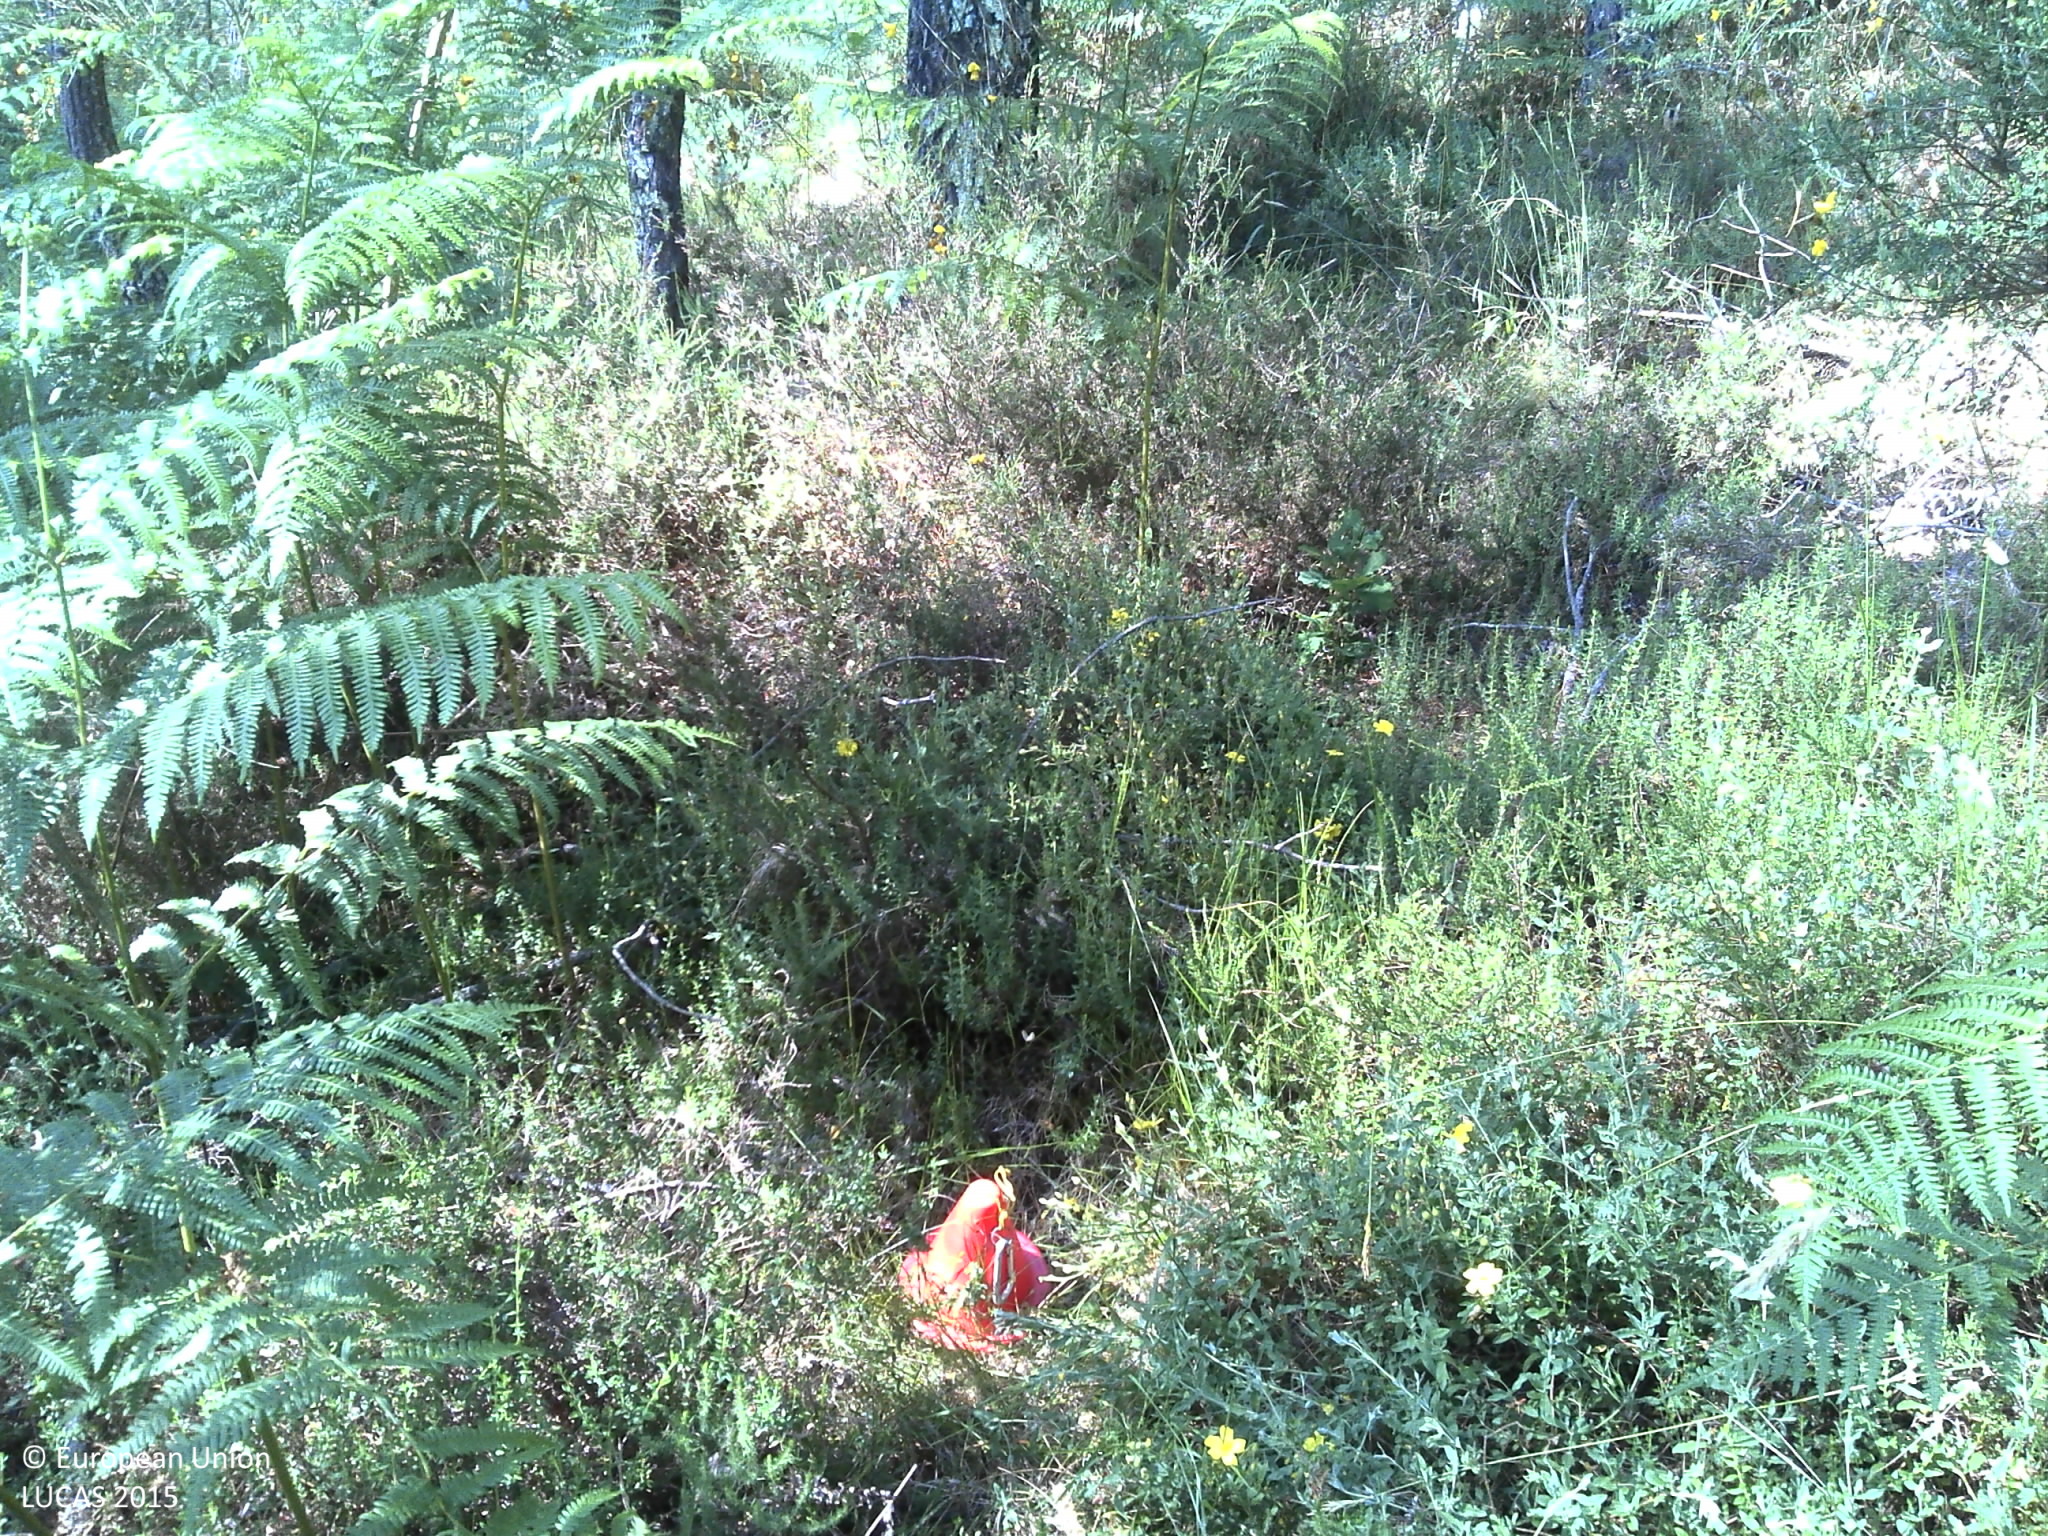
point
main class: Woodland
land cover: Pine dominated coniferous woodland
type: coniferous forest of the mediterranean region
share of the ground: > 75 %
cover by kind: coniferous forest trees 80 %, shrubs 20 %
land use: Forestry
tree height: > 5 m
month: June
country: PT
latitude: 42.0646
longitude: -8.2731
